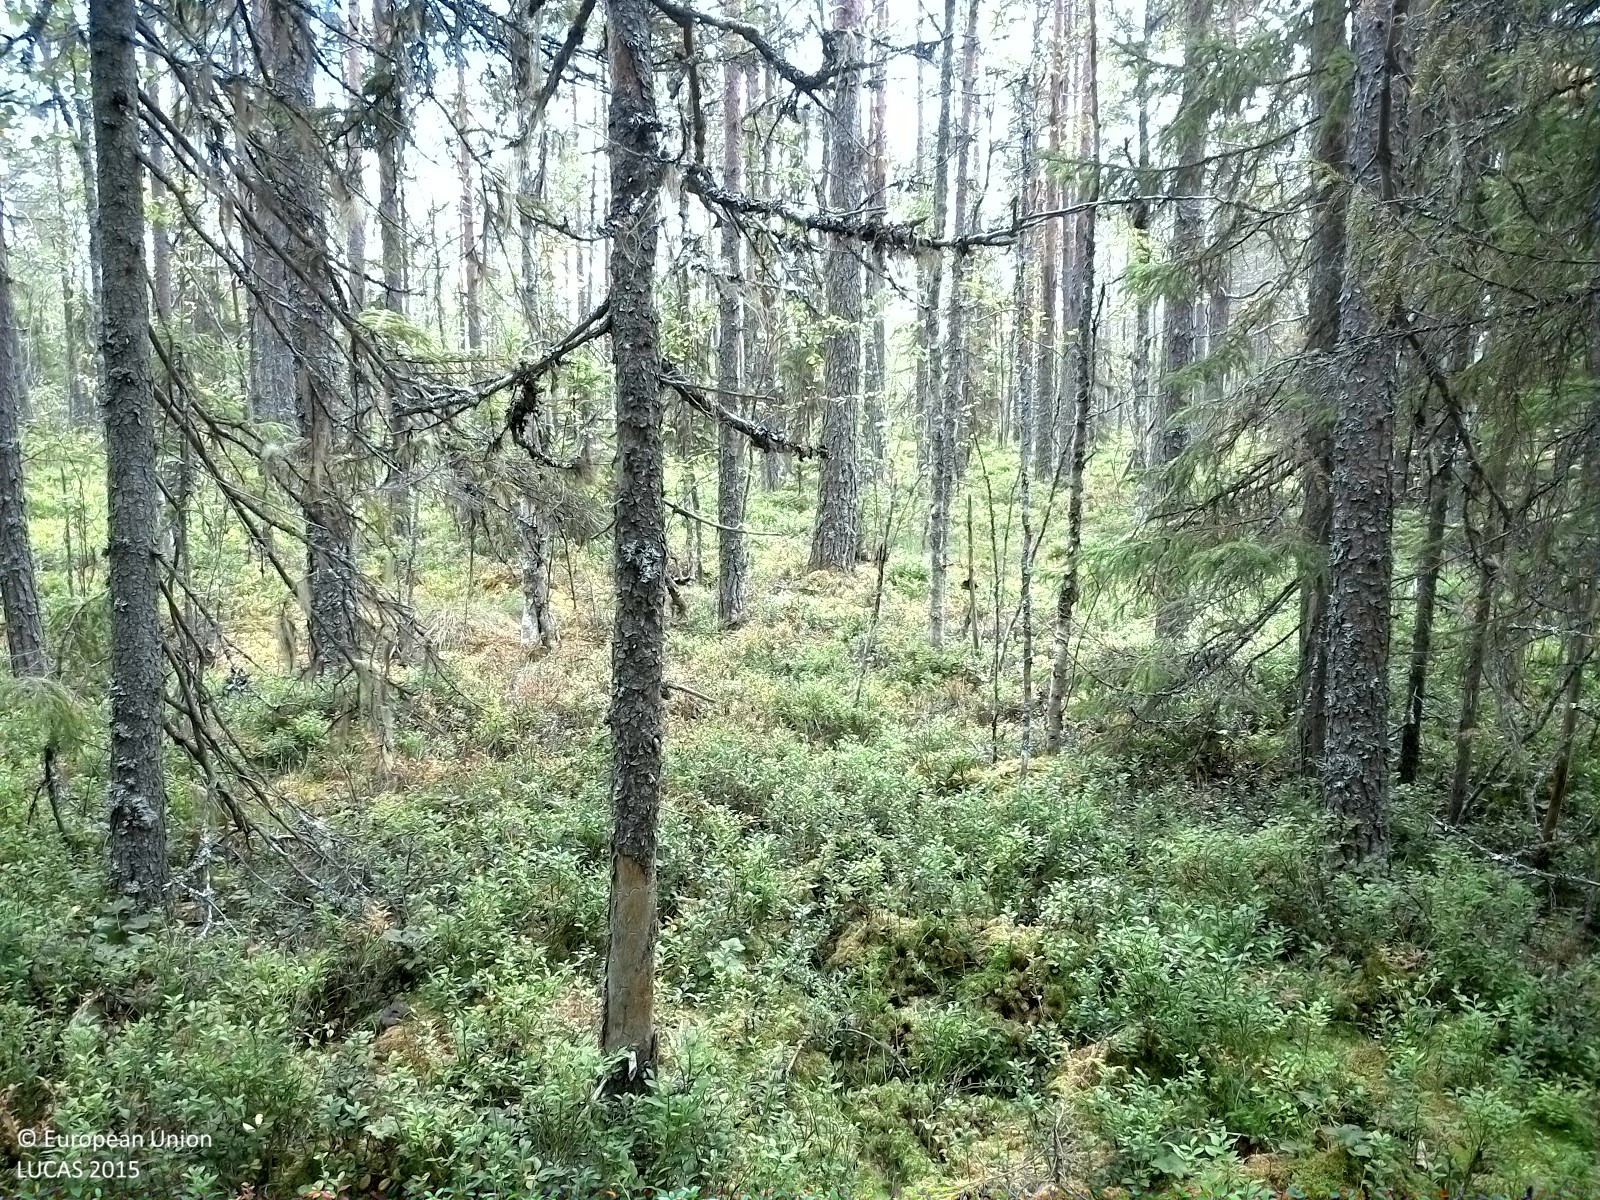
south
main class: Woodland
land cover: Spruce dominated mixed woodland
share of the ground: 50 - 75 %
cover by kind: shrubs 45 %, coniferous forest trees 40 %, broadleaved forest trees 15 %
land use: Forestry
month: August
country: SE
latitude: 62.4094
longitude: 16.2696
